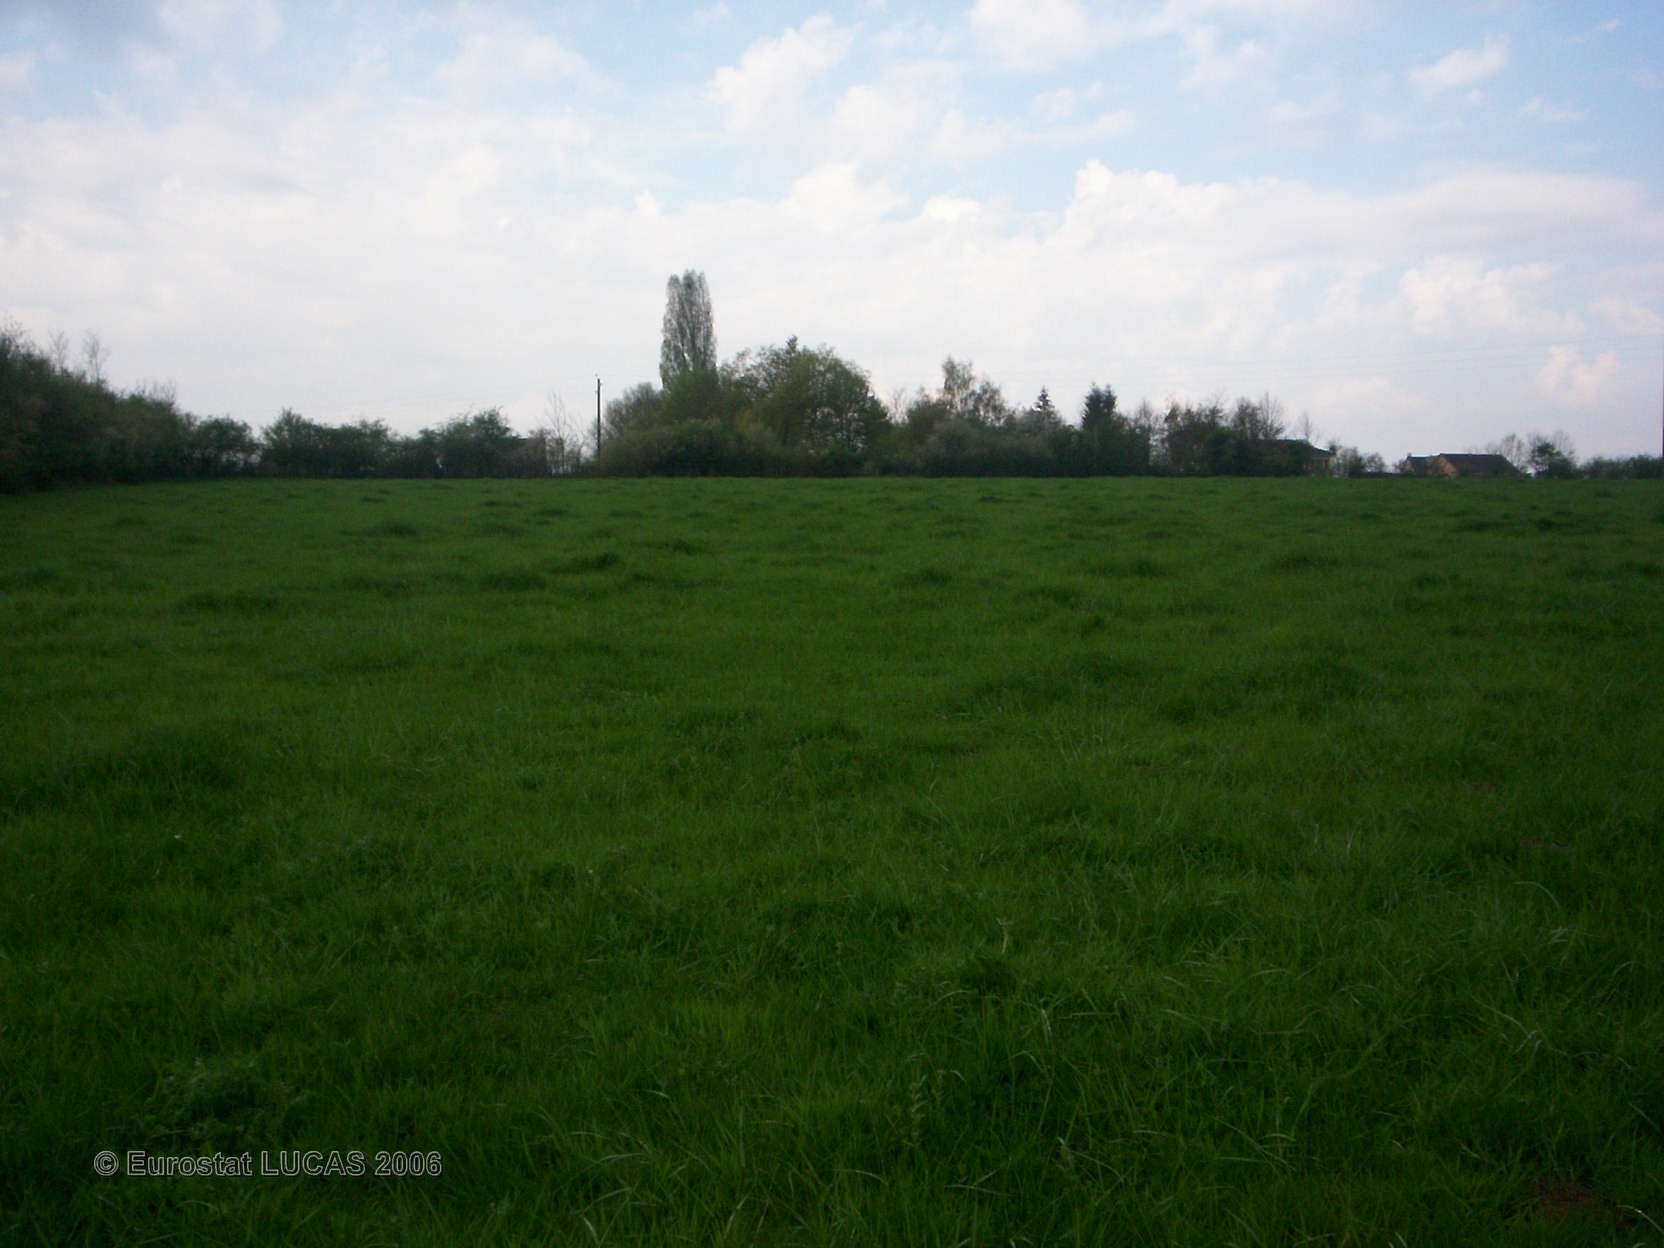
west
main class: Grassland
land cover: Grassland with sparse tree/shrub cover
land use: Agriculture (excluding fallow land and kitchen gardens)
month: April
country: FR
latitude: 47.4380
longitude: 2.9534
